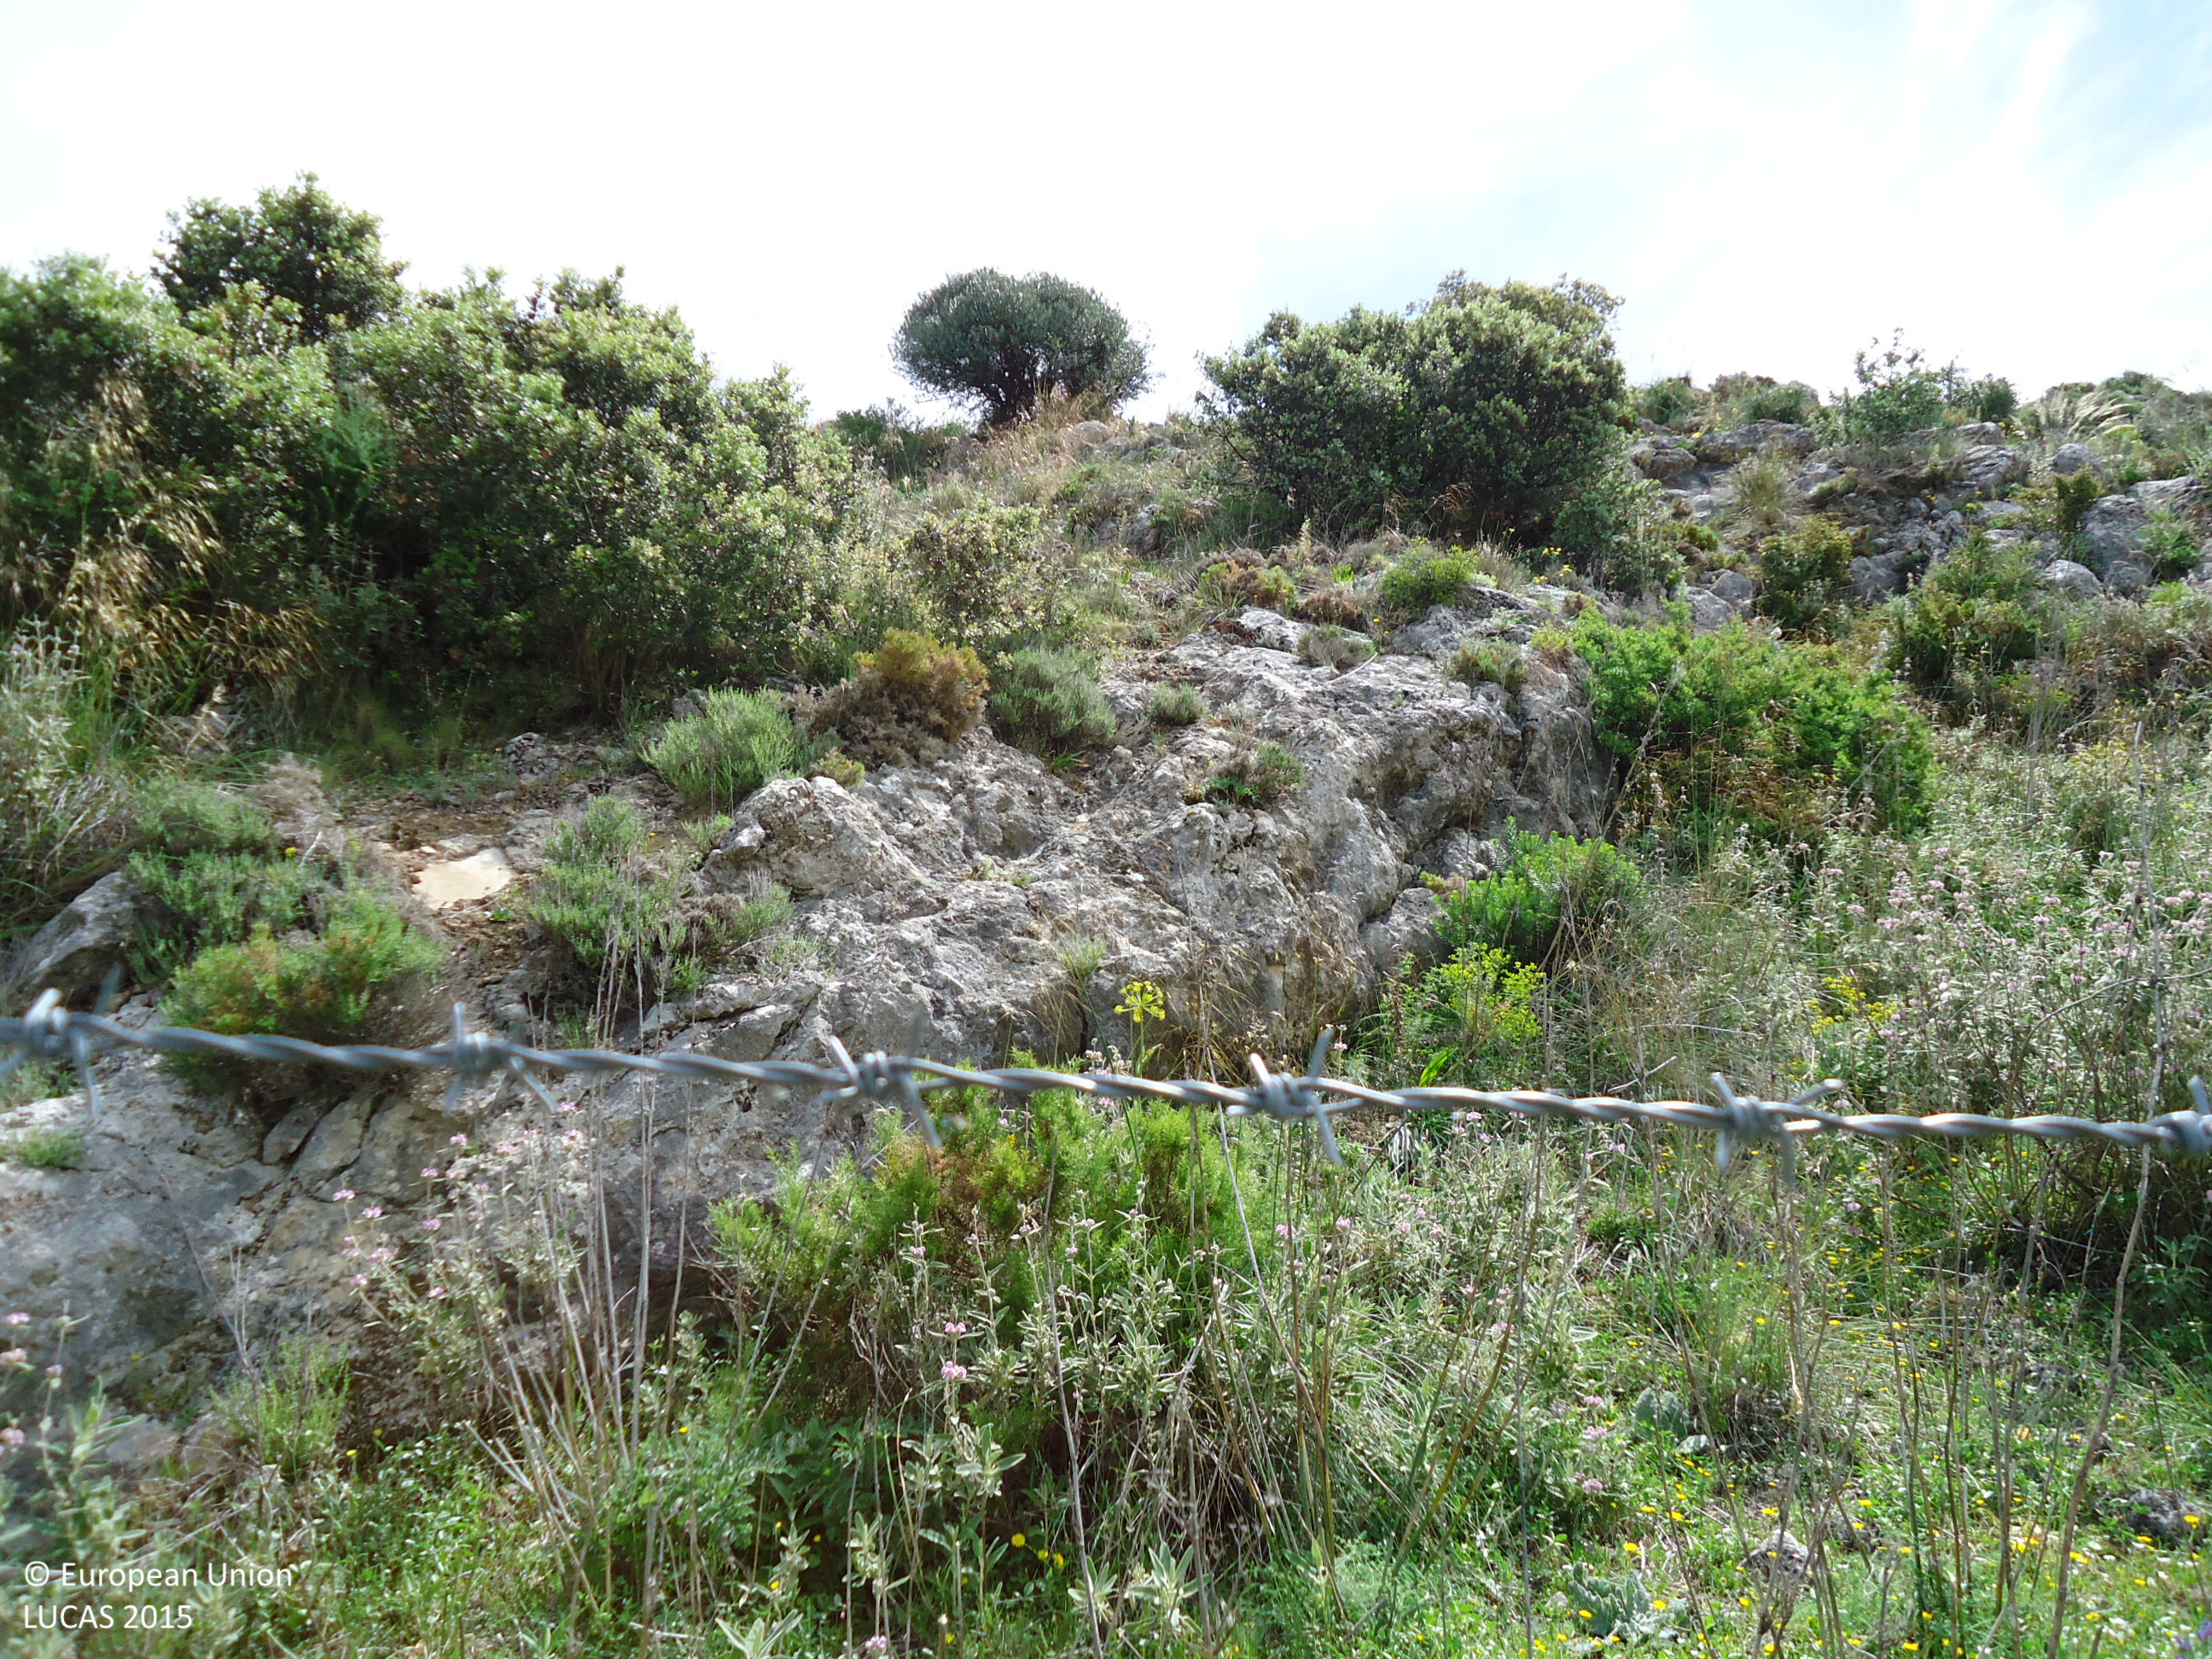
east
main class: Grassland
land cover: Grassland without tree/shrub cover
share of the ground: > 75 %
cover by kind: herbaceous plants 90 %, shrubs 5 %, consolidated bare surface 5 %
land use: Agriculture (excluding fallow land and kitchen gardens)
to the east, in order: Grassland without tree/shrub cover; Rock outcrops; Grassland without tree/shrub cover; Rock outcrops; Grassland without tree/shrub cover
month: May
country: ES
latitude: 36.9529
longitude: -5.0158
